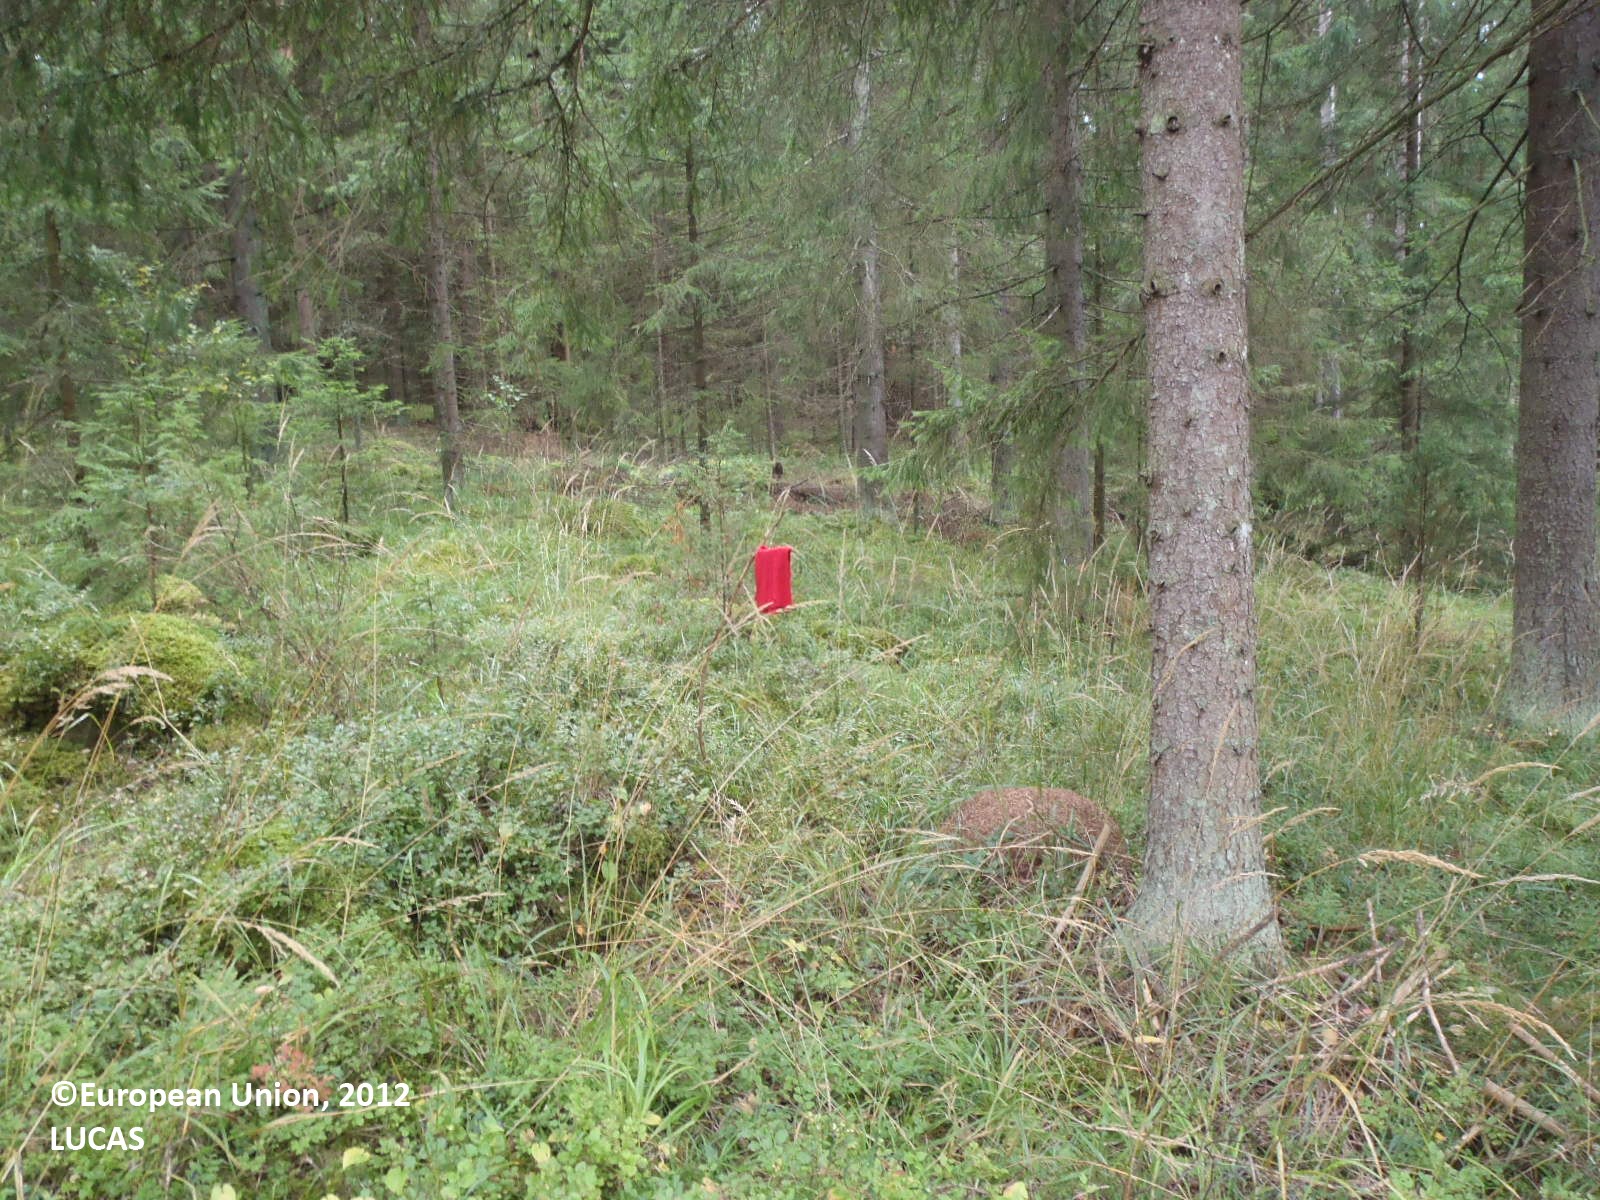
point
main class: Woodland
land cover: Spruce dominated coniferous woodland
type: boreal forest
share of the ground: > 75 %
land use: Forestry
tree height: > 5 m
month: August
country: FI
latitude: 60.8498
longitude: 22.4532
